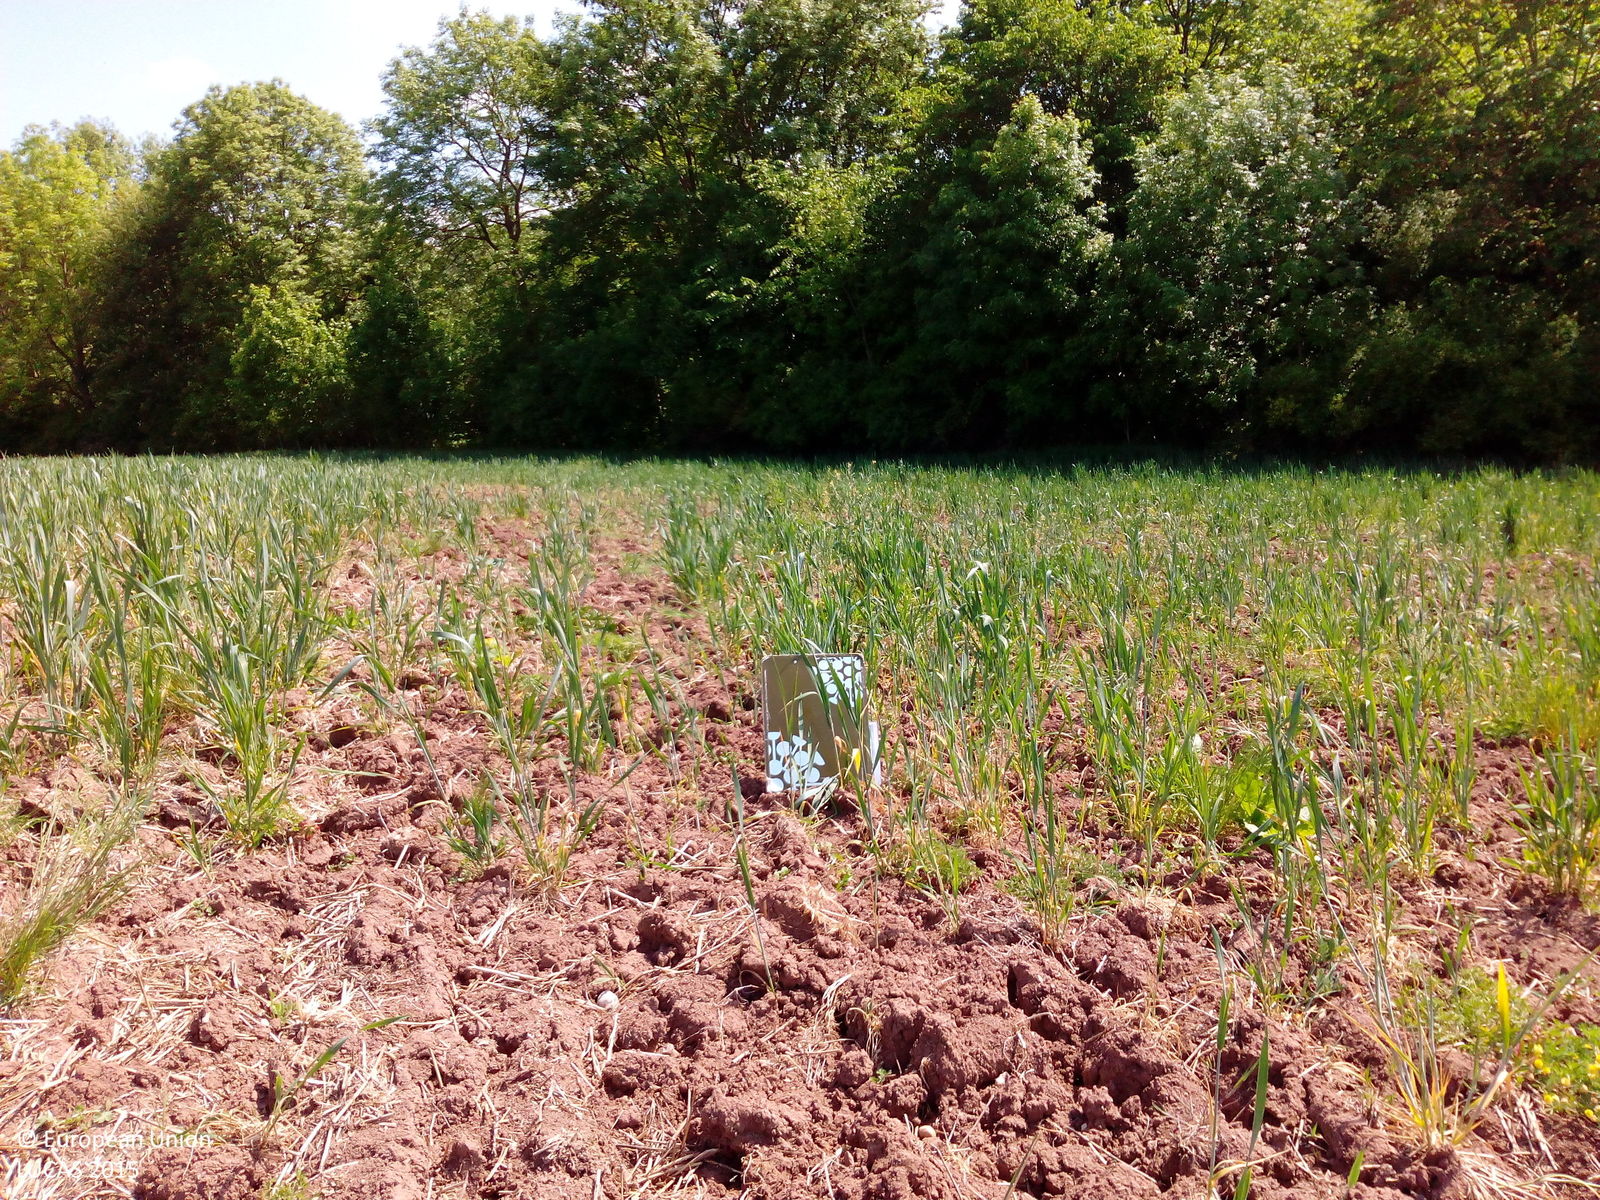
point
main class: Cropland
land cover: Common wheat
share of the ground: 25 - 50 %
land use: Agriculture (excluding fallow land and kitchen gardens)
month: May
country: DE
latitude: 50.8919
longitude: 11.6346
